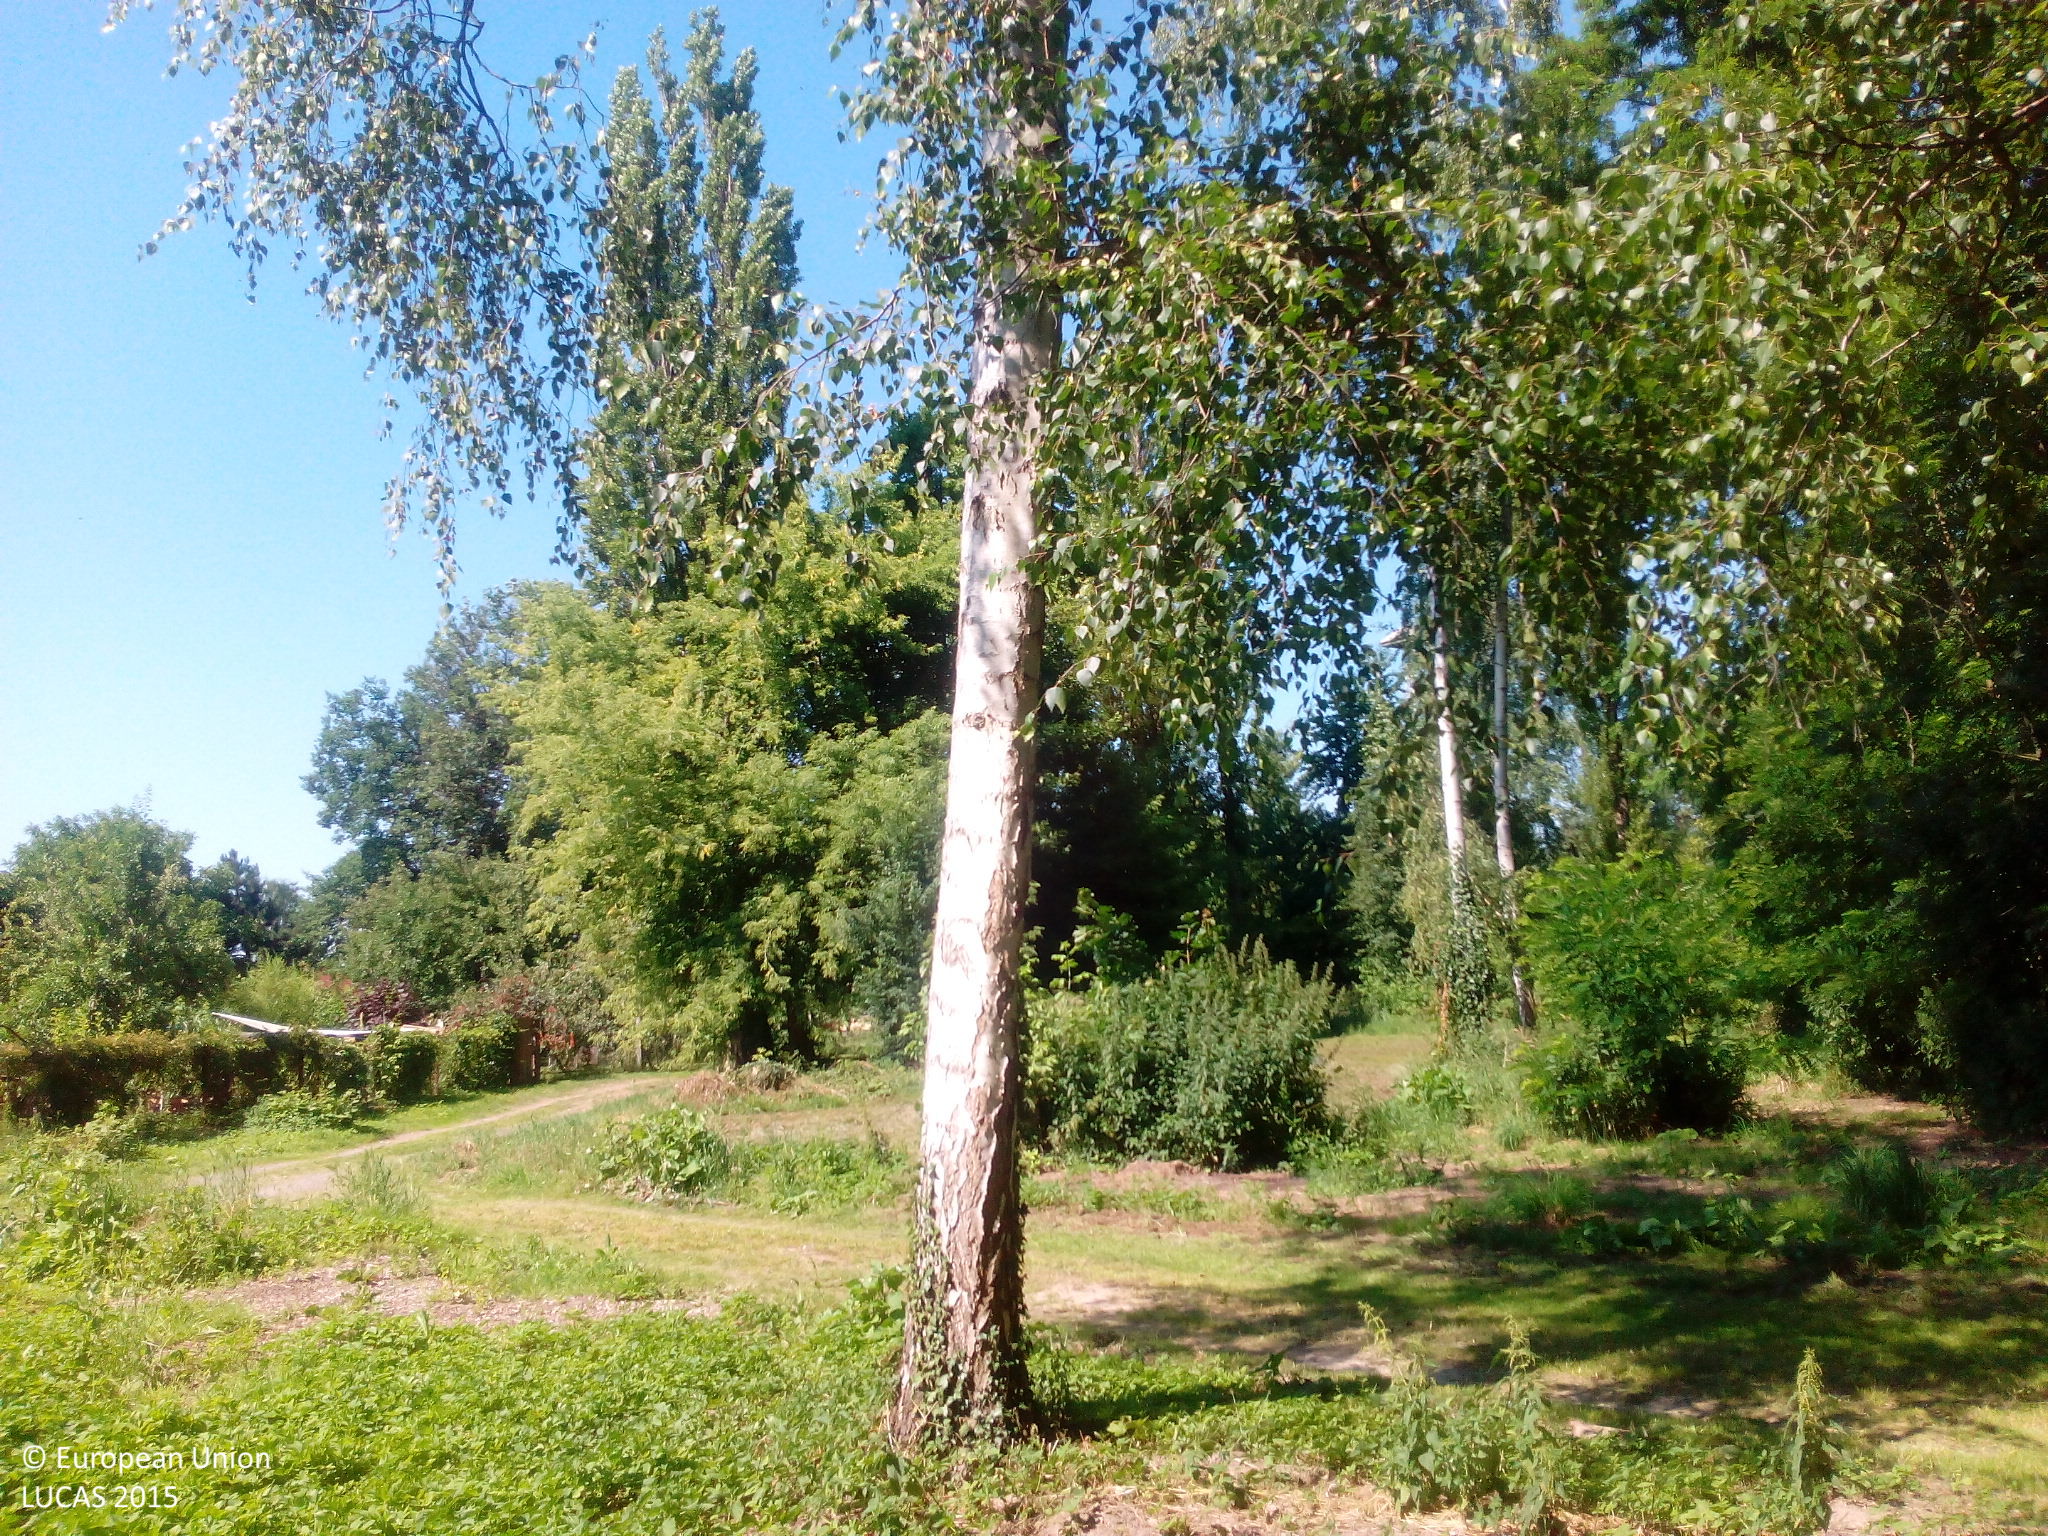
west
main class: Woodland
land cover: Broadleaved woodland
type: mesophytic deciduous forest
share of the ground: > 75 %
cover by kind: broadleaved forest trees 90 %, herbaceous plants 10 %
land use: Forestry
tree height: > 5 m
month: July
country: DE
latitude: 51.2574
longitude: 13.1096
